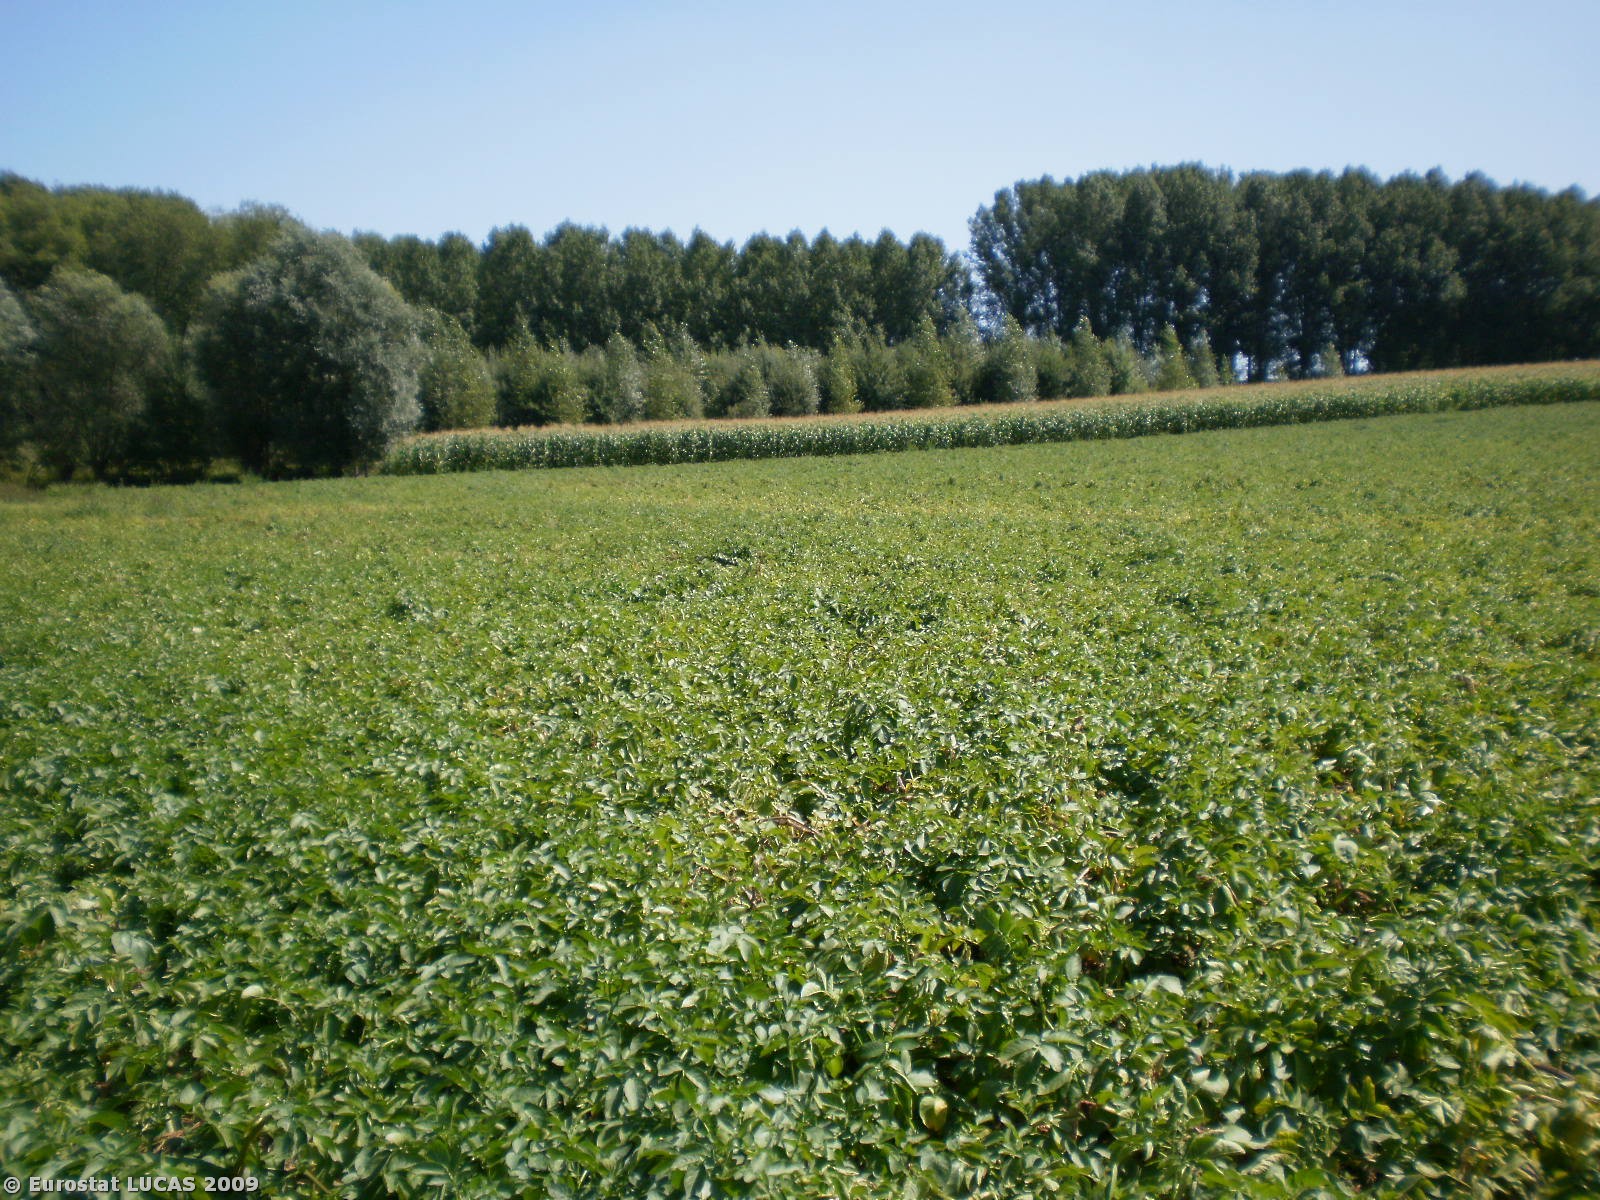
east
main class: Grassland
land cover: Grassland without tree/shrub cover
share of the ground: > 75 %
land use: Agriculture (excluding fallow land and kitchen gardens)
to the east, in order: Grassland without tree/shrub cover; Fences; Broadleaved woodland; Spontaneously vegetated surfaces; Broadleaved woodland
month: August
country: BE
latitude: 50.8265
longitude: 3.7894
